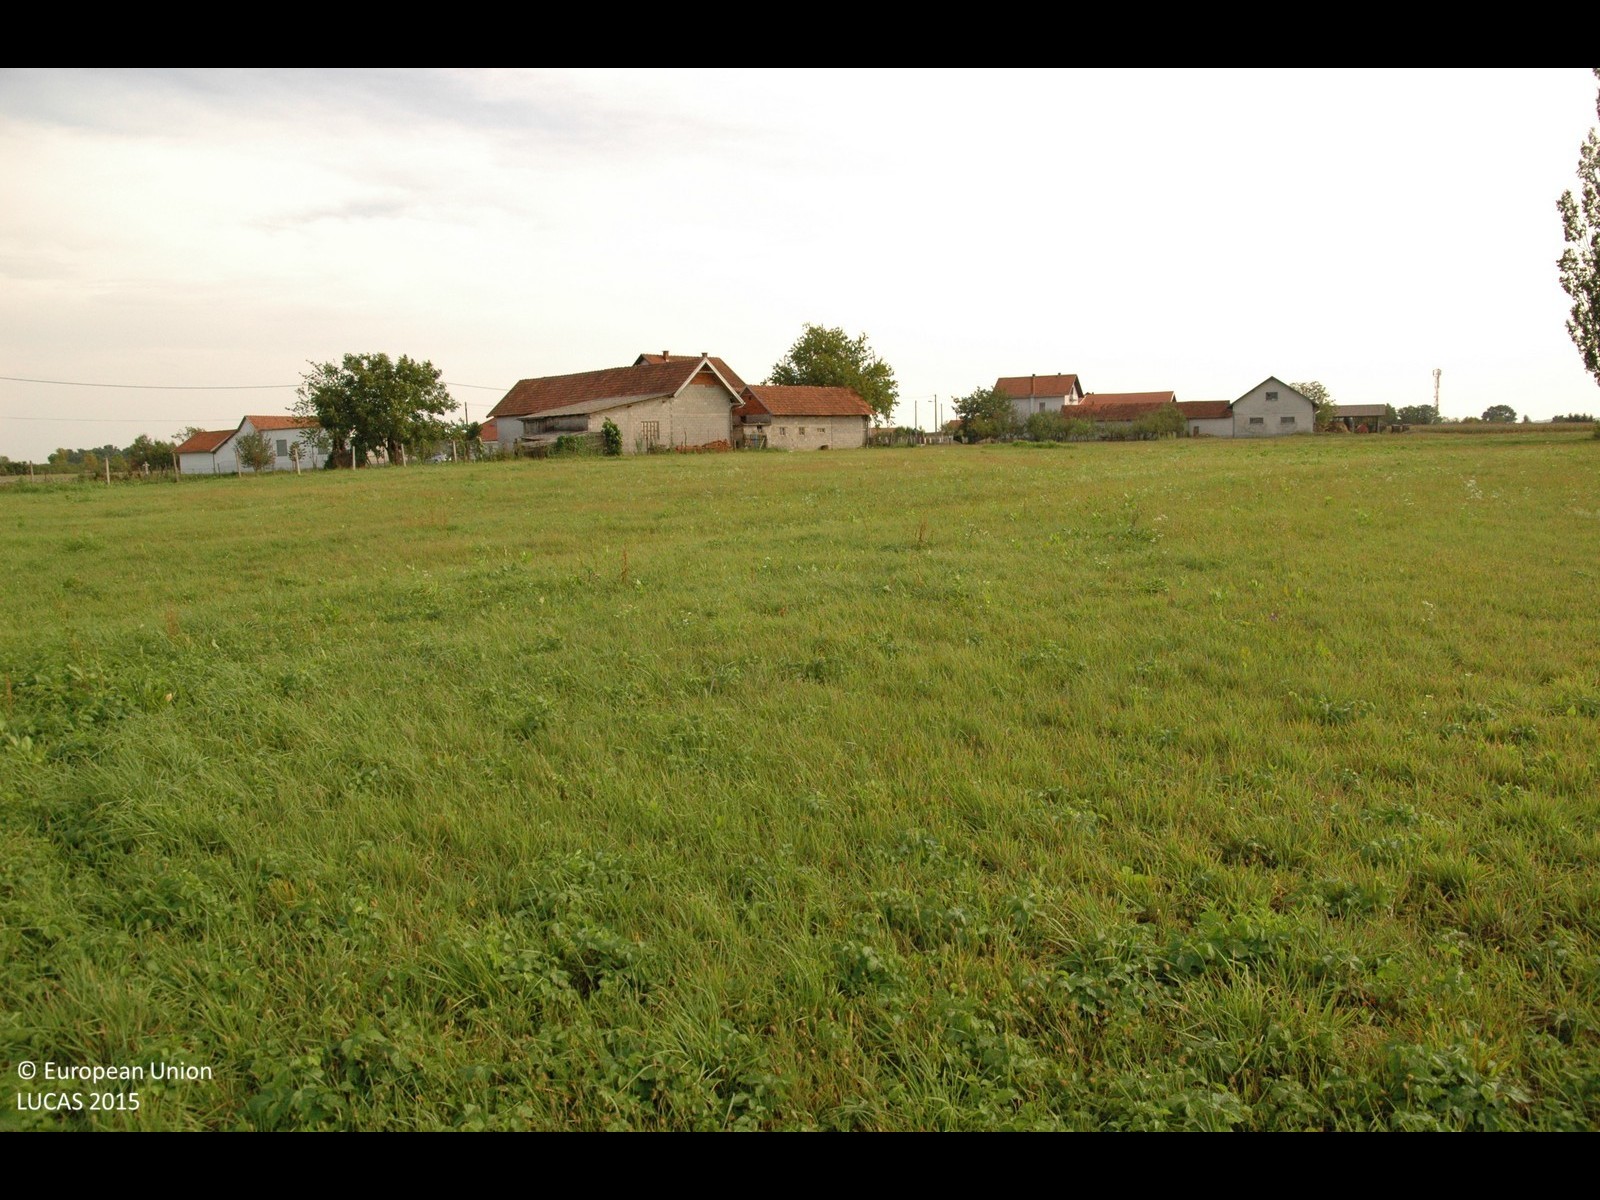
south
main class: Grassland
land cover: Grassland without tree/shrub cover
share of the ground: > 75 %
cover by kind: herbaceous plants 100 %
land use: Agriculture (excluding fallow land and kitchen gardens)
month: September
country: HR
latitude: 45.7176
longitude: 15.9201
